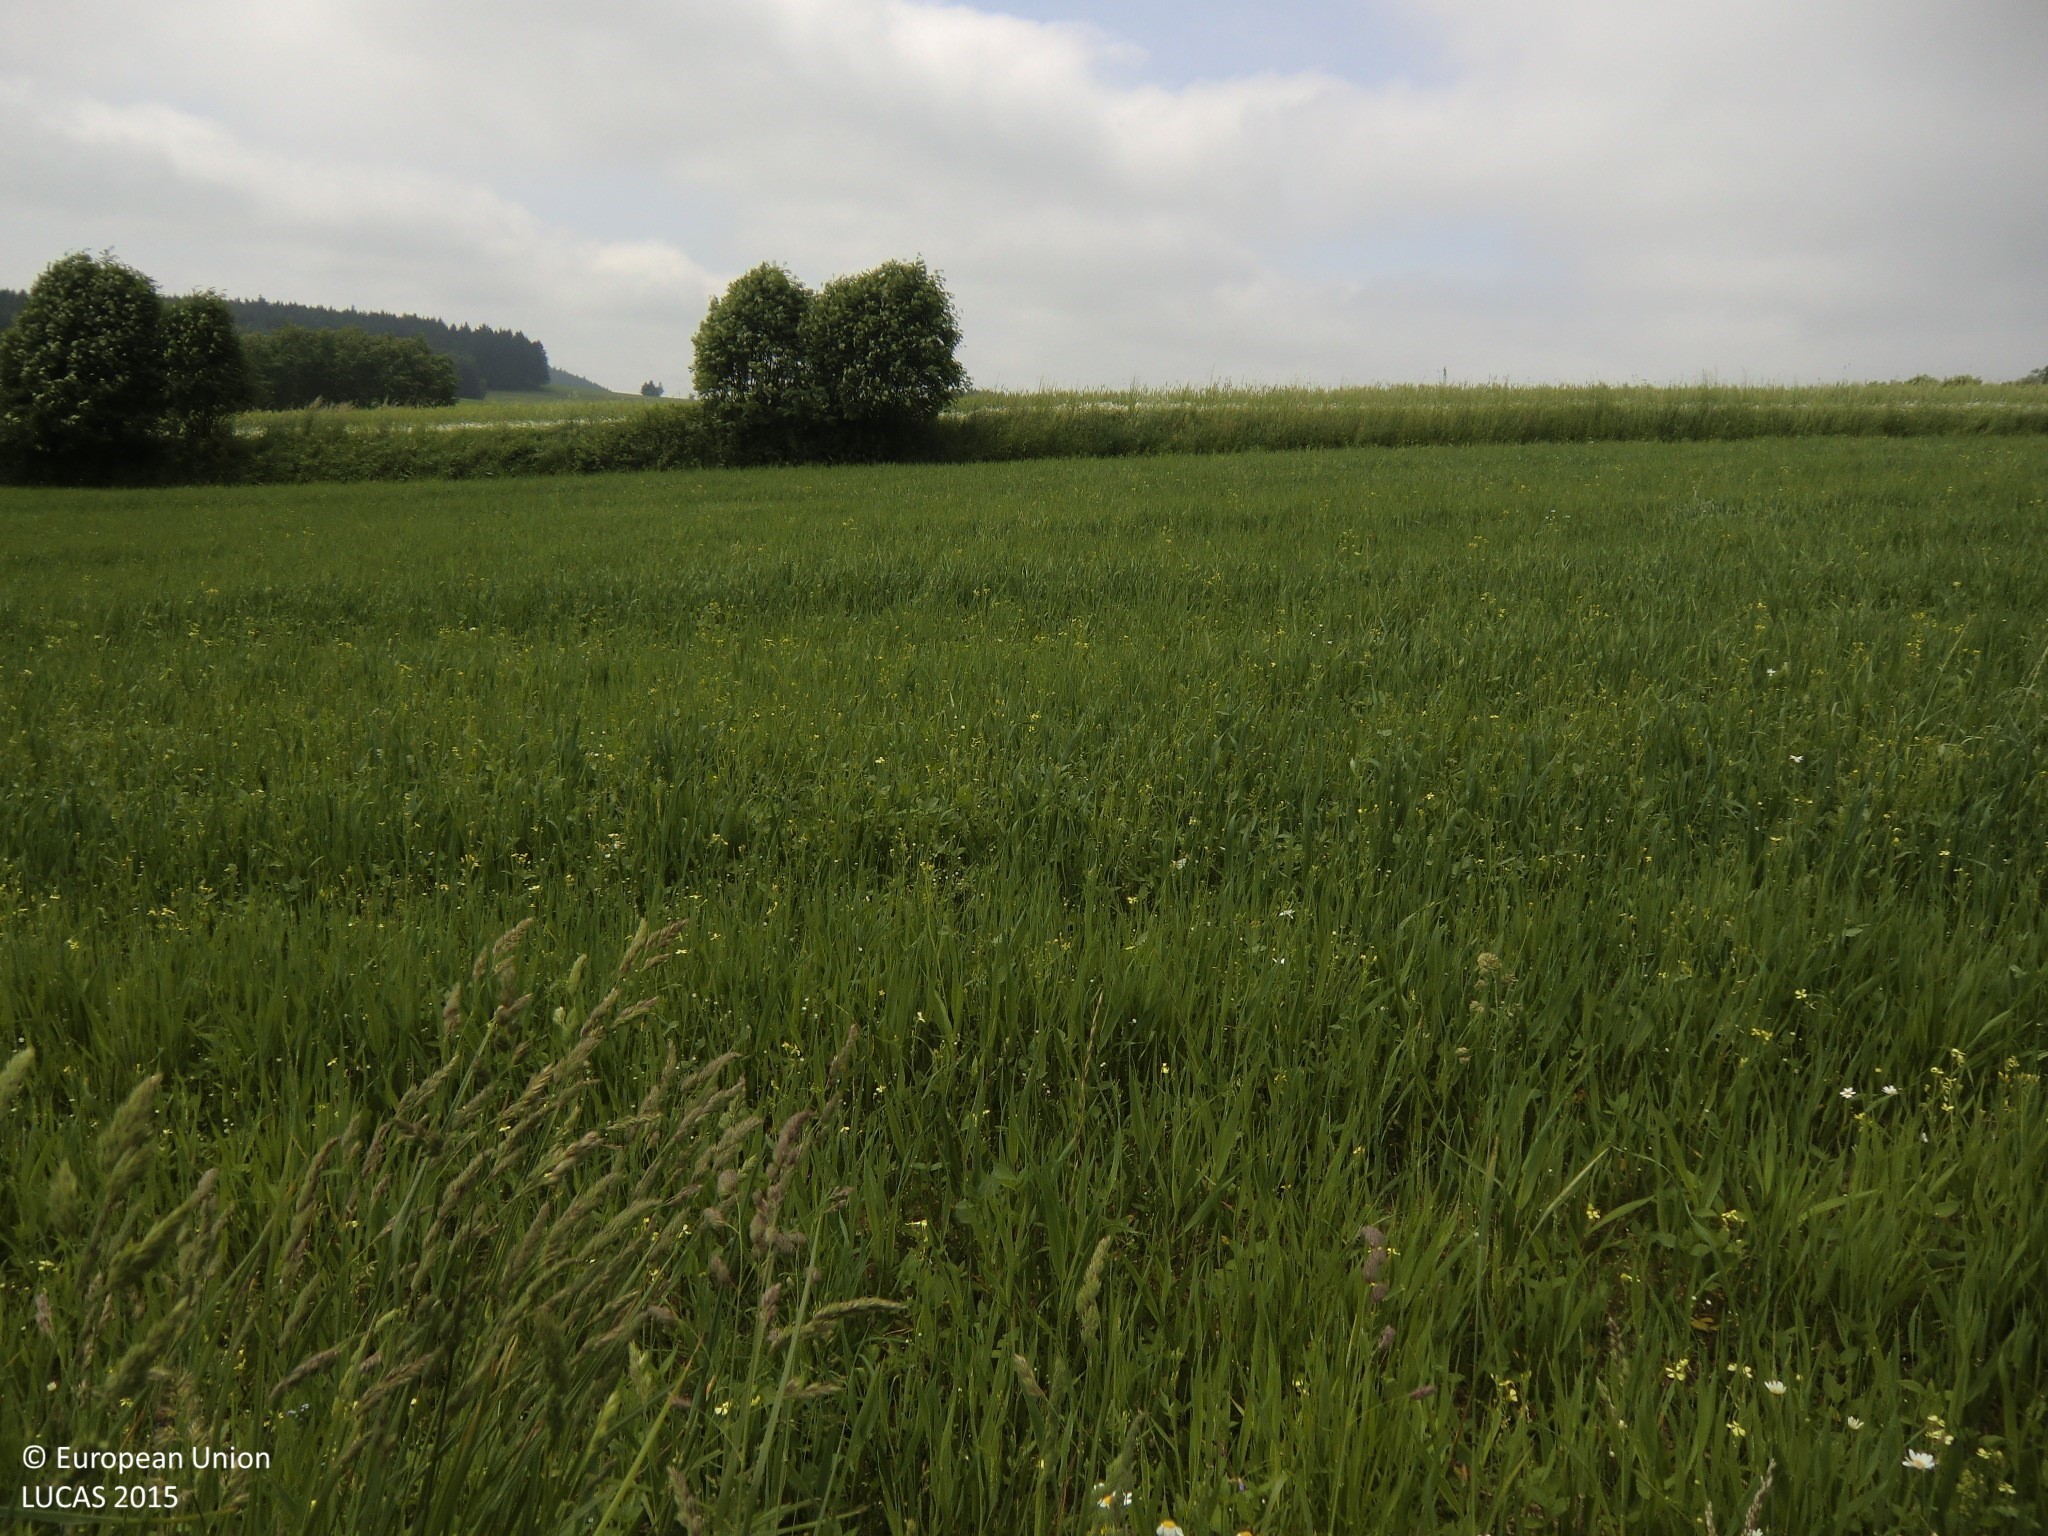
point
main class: Cropland
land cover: Rye
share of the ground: > 75 %
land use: Agriculture (excluding fallow land and kitchen gardens)
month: June
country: AT
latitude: 48.4423
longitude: 14.8272
